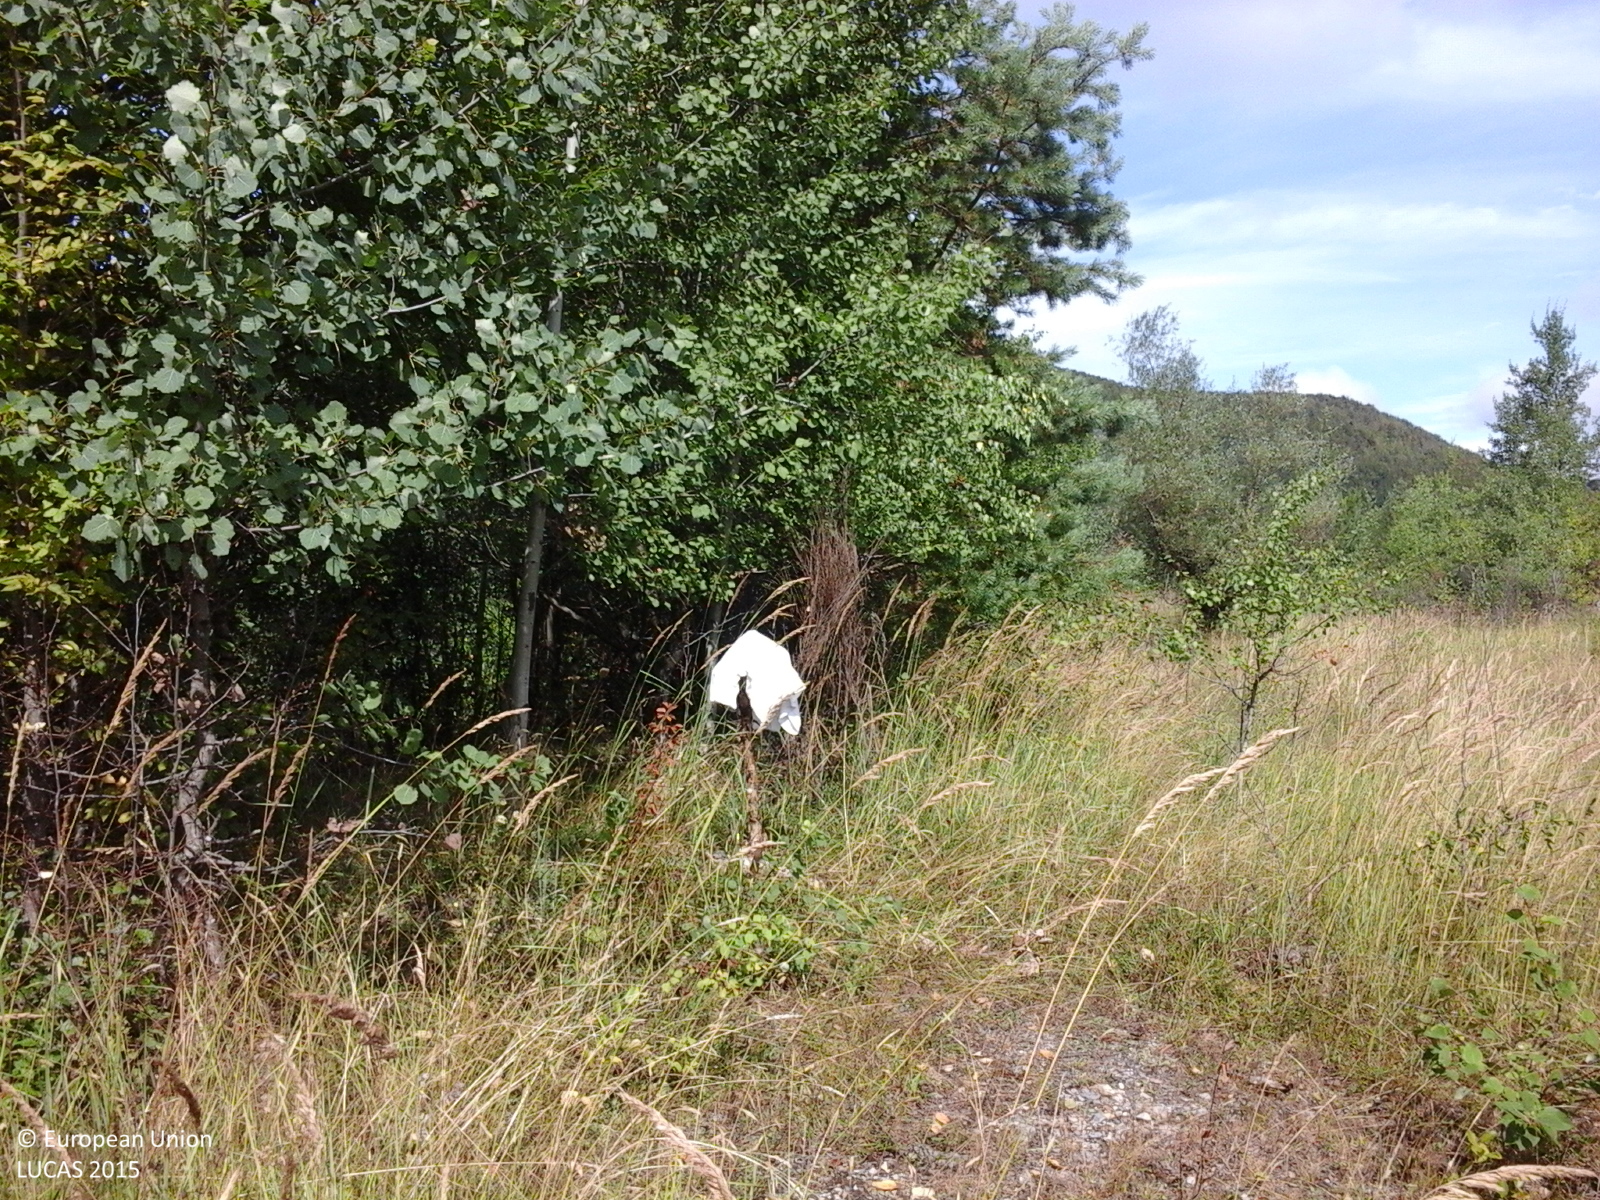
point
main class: Woodland
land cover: Broadleaved woodland
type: beech forest
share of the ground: > 75 %
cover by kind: broadleaved forest trees 100 %
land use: Forestry
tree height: > 5 m
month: August
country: RO
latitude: 45.0552
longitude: 21.8300
